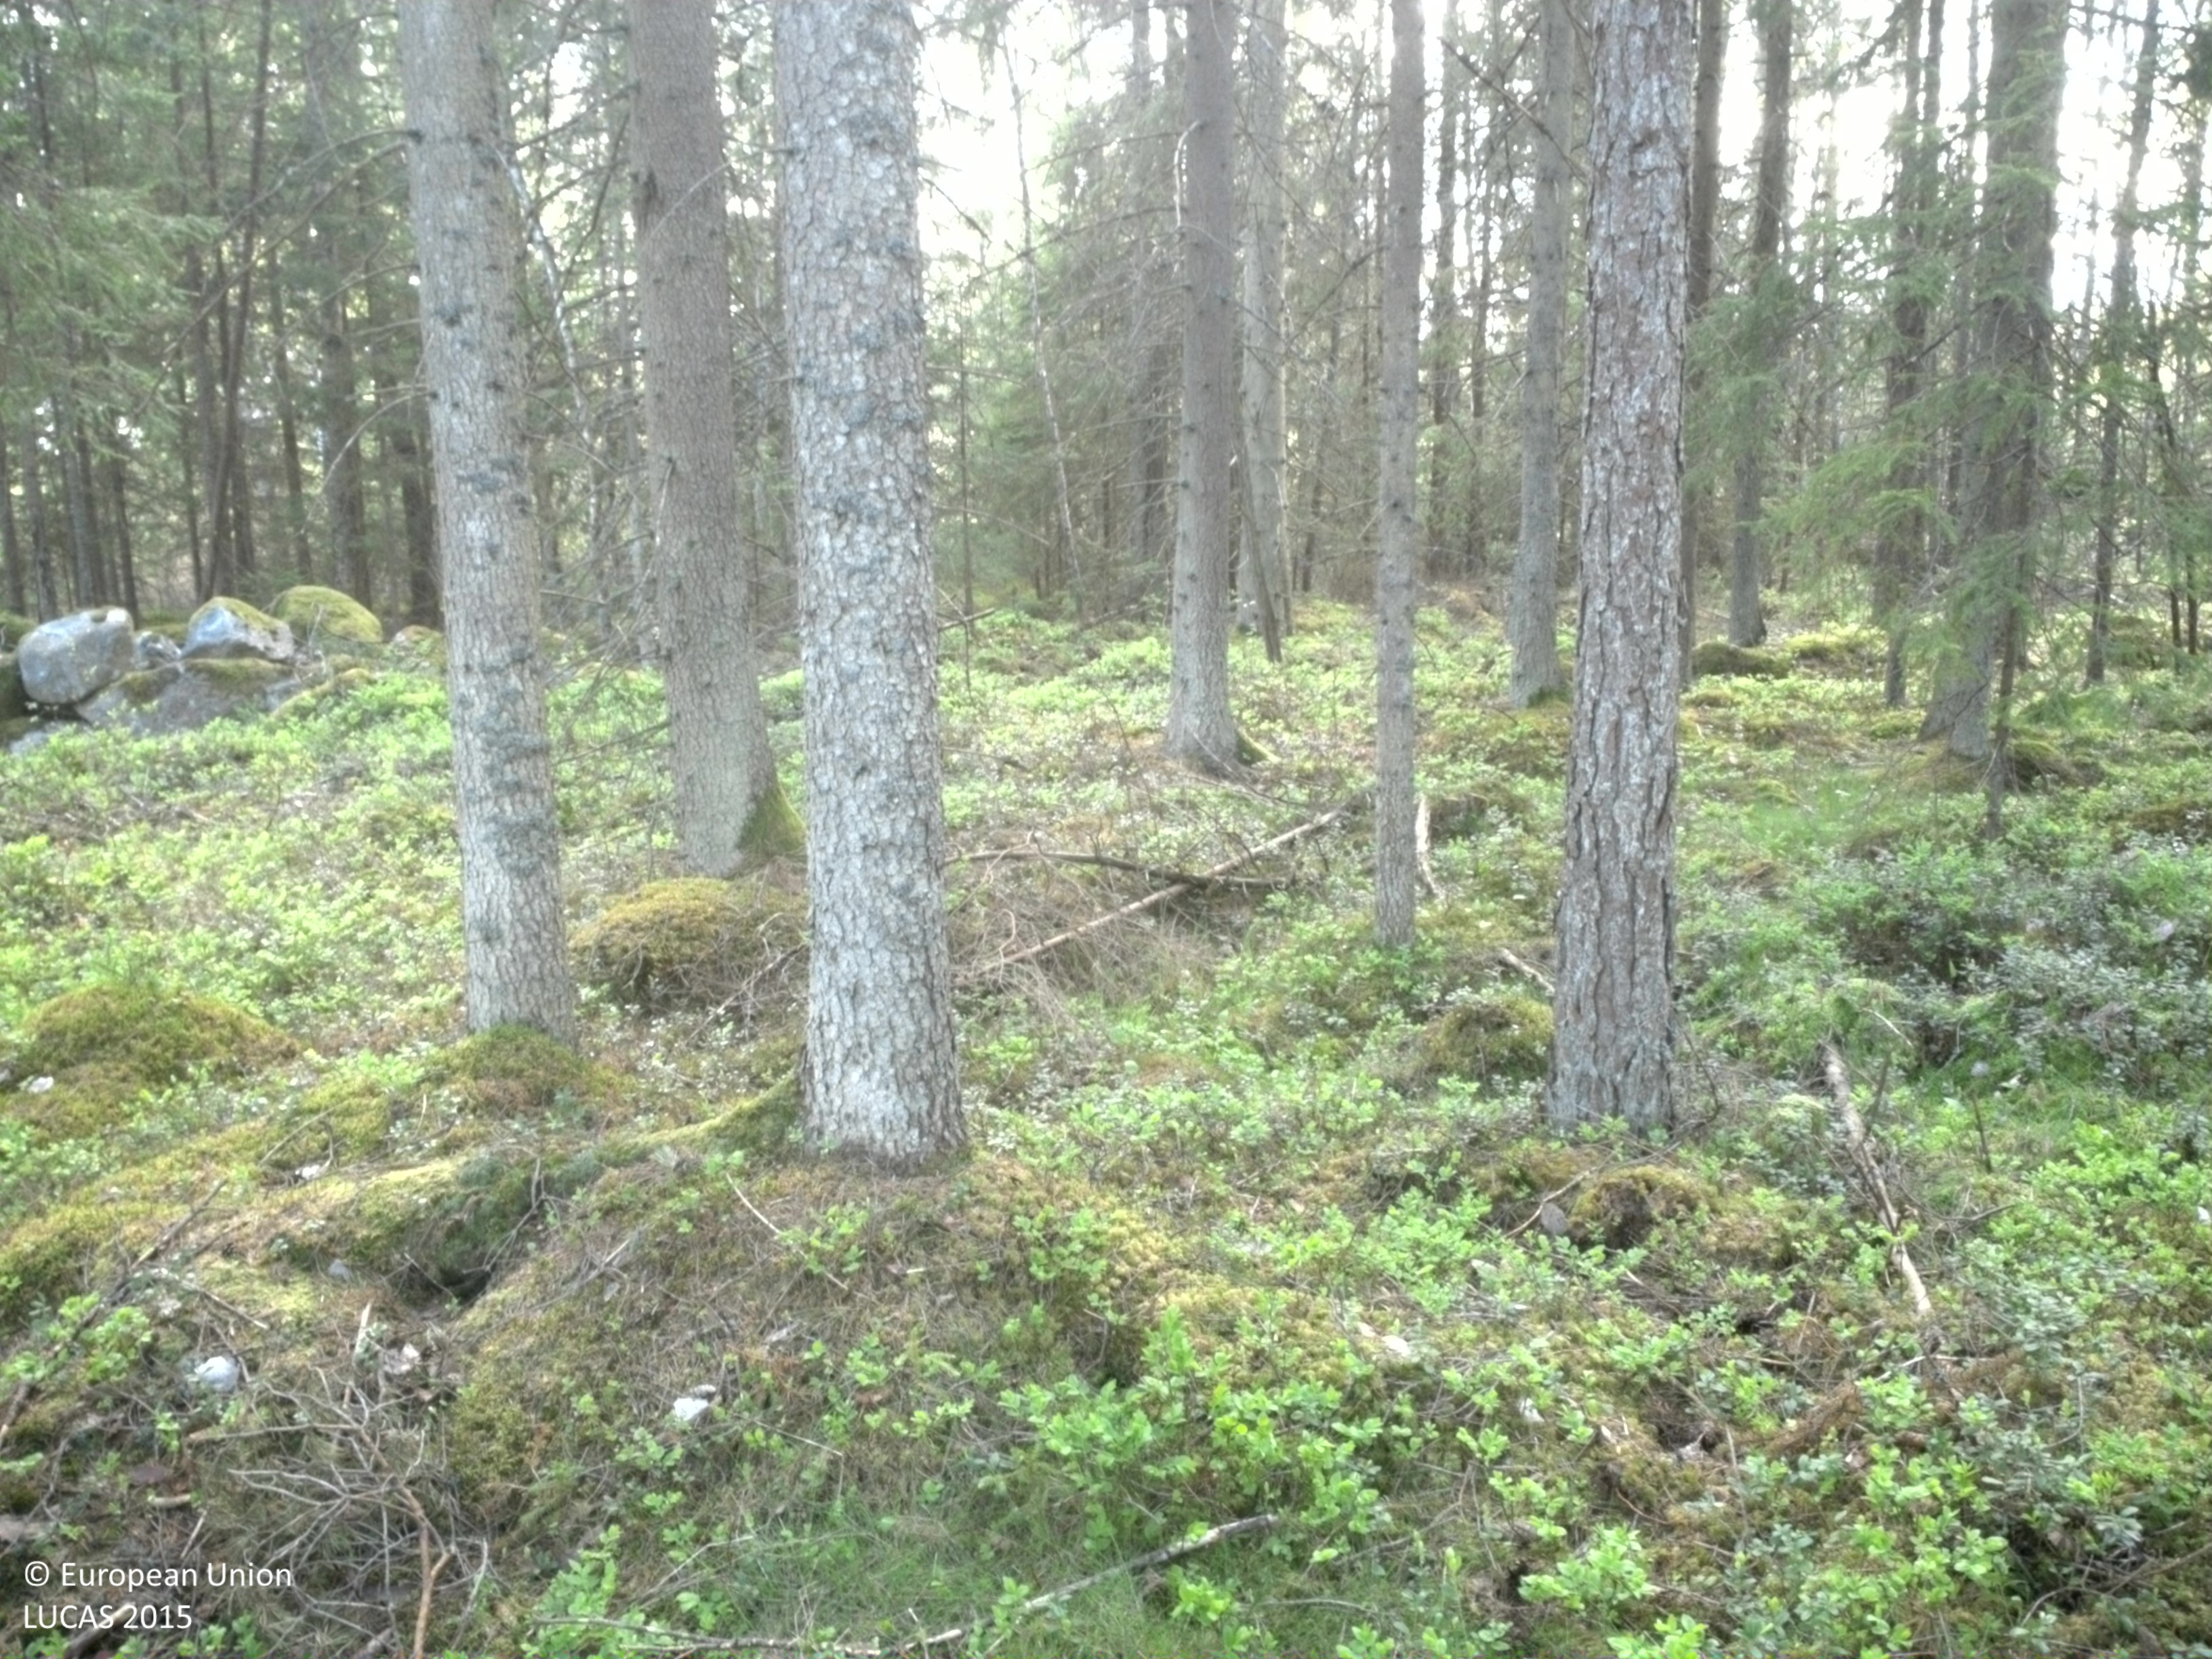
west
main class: Woodland
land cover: Spruce dominated coniferous woodland
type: boreal forest
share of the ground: 50 - 75 %
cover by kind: coniferous forest trees 50 %, shrubs 25 %, lichens and mosses 15 %, herbaceous plants 10 %
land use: Forestry
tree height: > 5 m
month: May
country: SE
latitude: 56.6039
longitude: 15.2273
